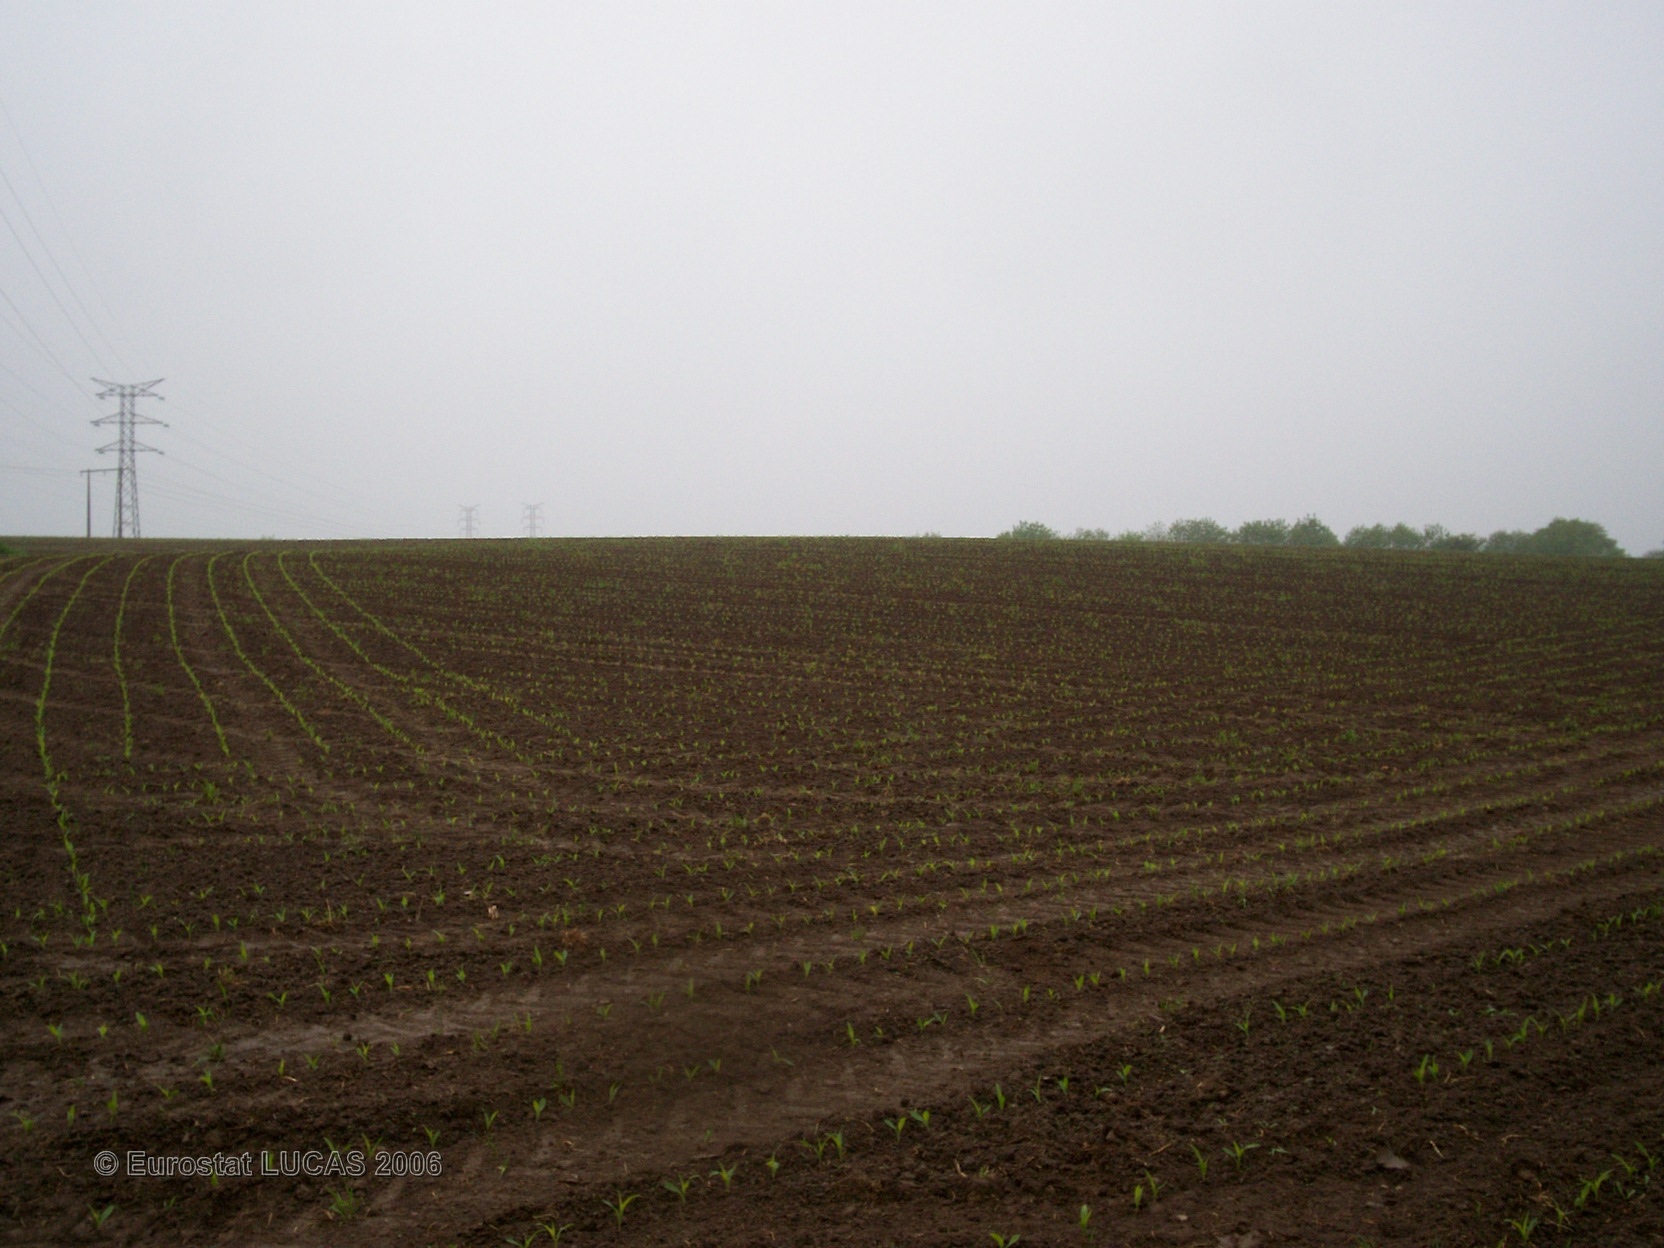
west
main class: Cropland
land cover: Maize
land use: Agriculture (excluding fallow land and kitchen gardens)
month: May
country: FR
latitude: 47.9099
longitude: -3.8501
